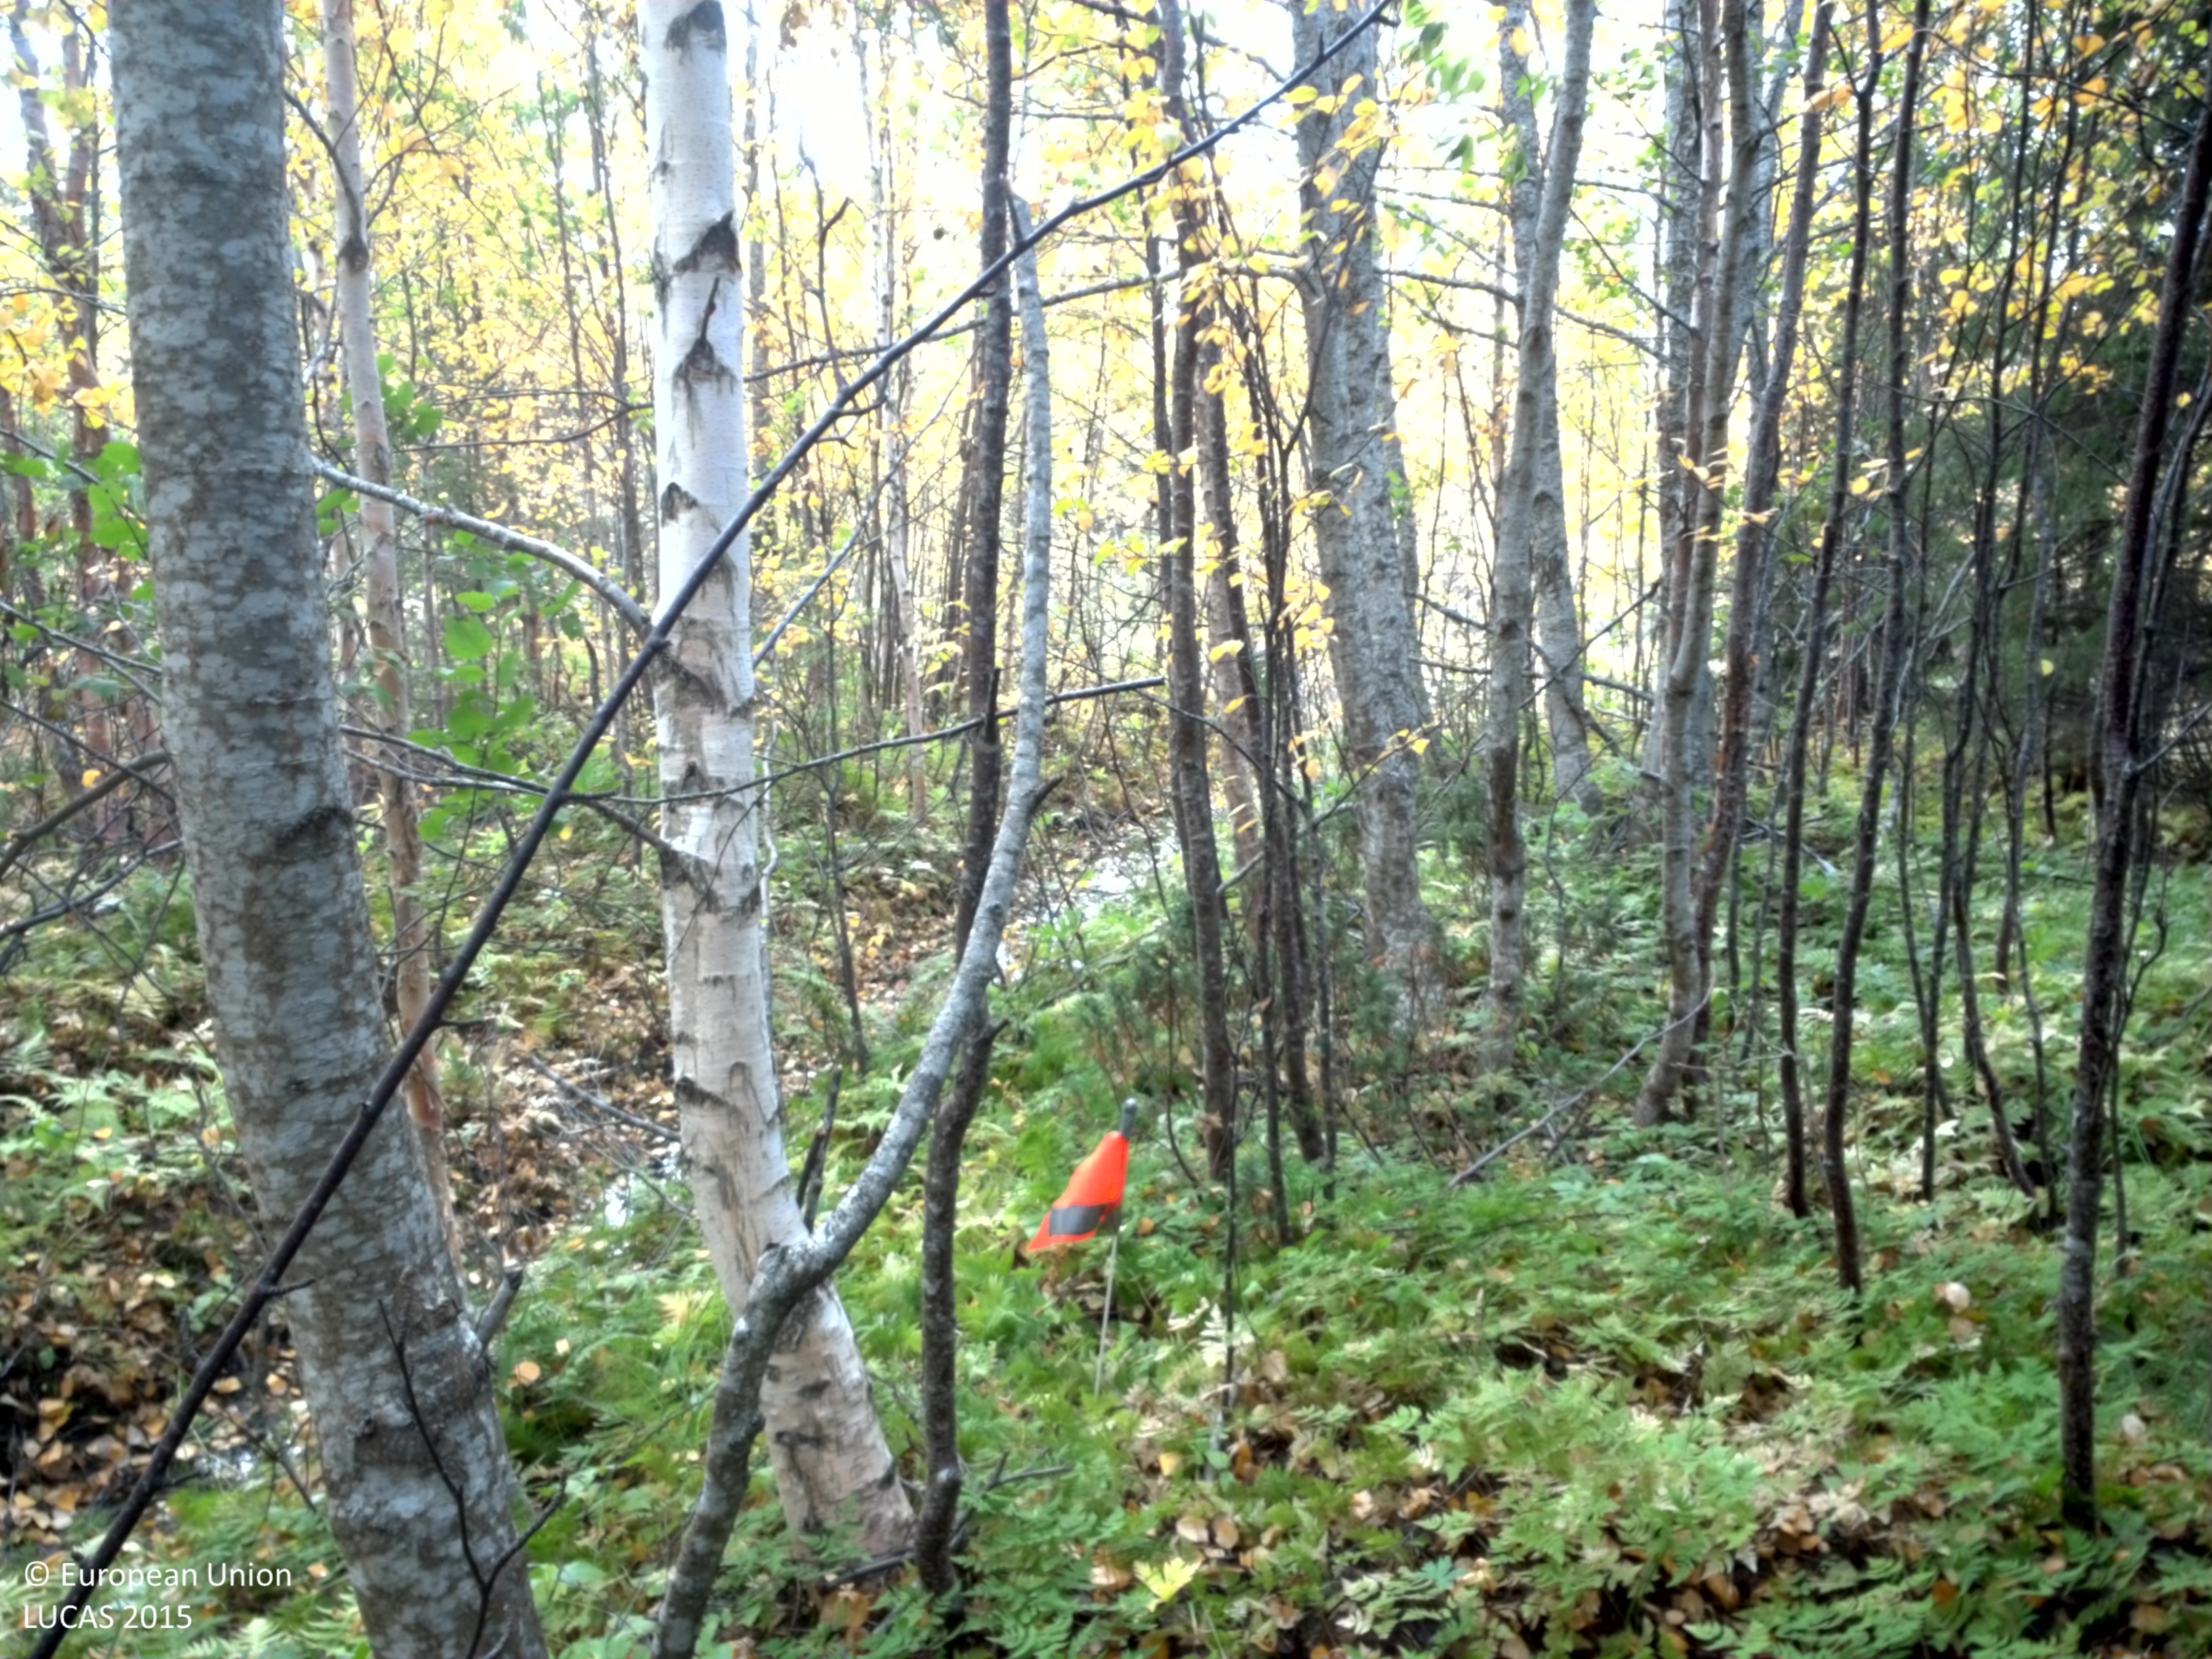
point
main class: Woodland
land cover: Broadleaved woodland
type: non-riverine alder, birch or aspen forest
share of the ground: > 75 %
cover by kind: broadleaved forest trees 70 %, herbaceous plants 15 %, coniferous forest trees 10 %, shrubs 5 %
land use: Semi-natural and natural areas not in use
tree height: > 5 m
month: September
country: SE
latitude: 65.3834
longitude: 16.1810
